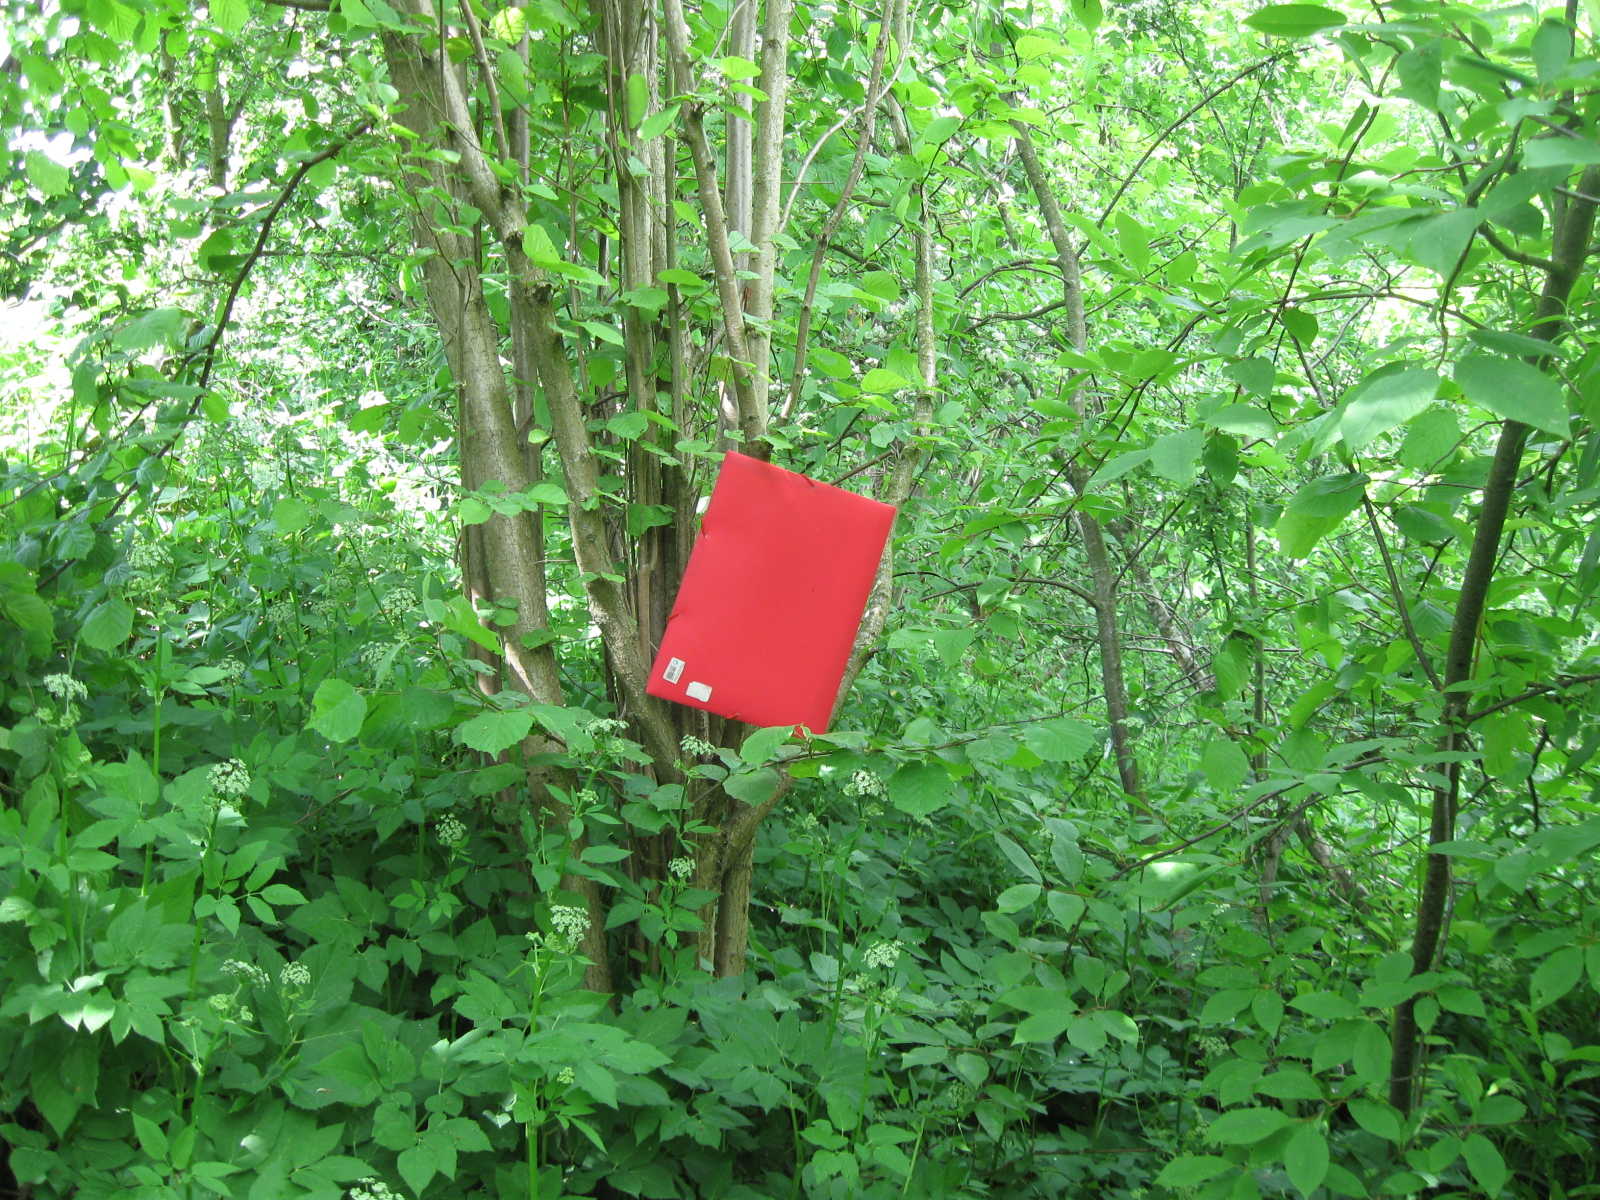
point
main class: Woodland
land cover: Broadleaved woodland
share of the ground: > 75 %
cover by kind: broadleaved forest trees 75 %, herbaceous plants 25 %
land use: Semi-natural and natural areas not in use
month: June
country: LT
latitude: 54.3488
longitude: 23.7330
